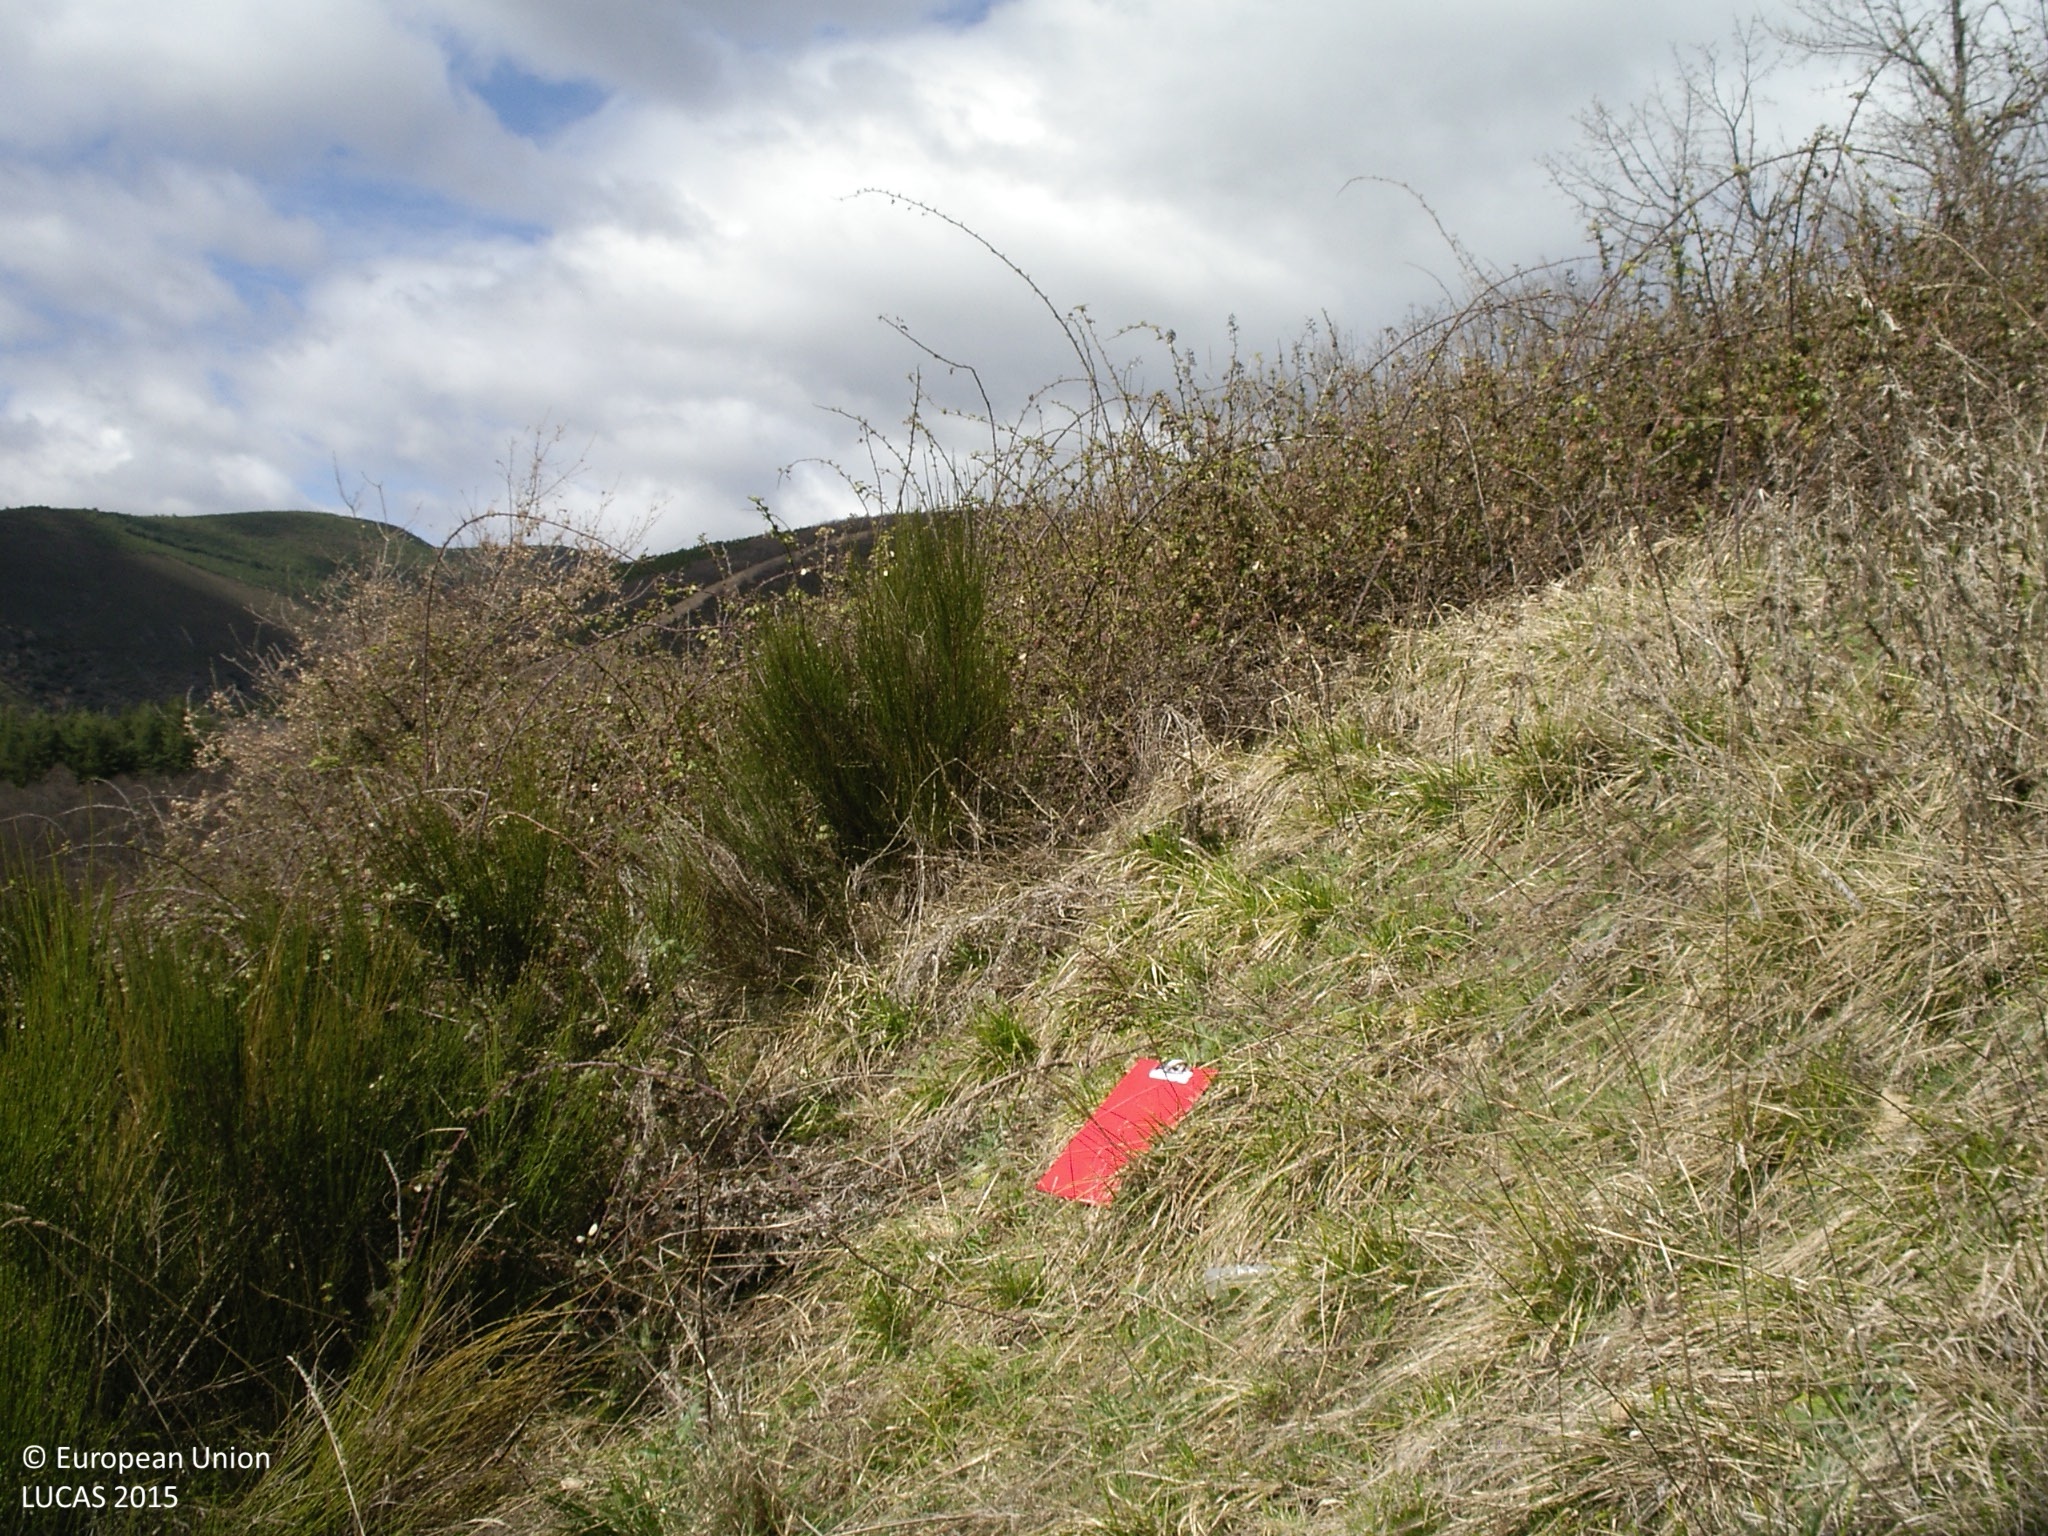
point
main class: Grassland
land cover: Grassland without tree/shrub cover
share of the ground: > 75 %
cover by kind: herbaceous plants 55 %, shrubs 5 %
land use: Agriculture (excluding fallow land and kitchen gardens)
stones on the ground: < 10 %
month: March
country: ES
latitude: 42.7153
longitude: -6.4436
